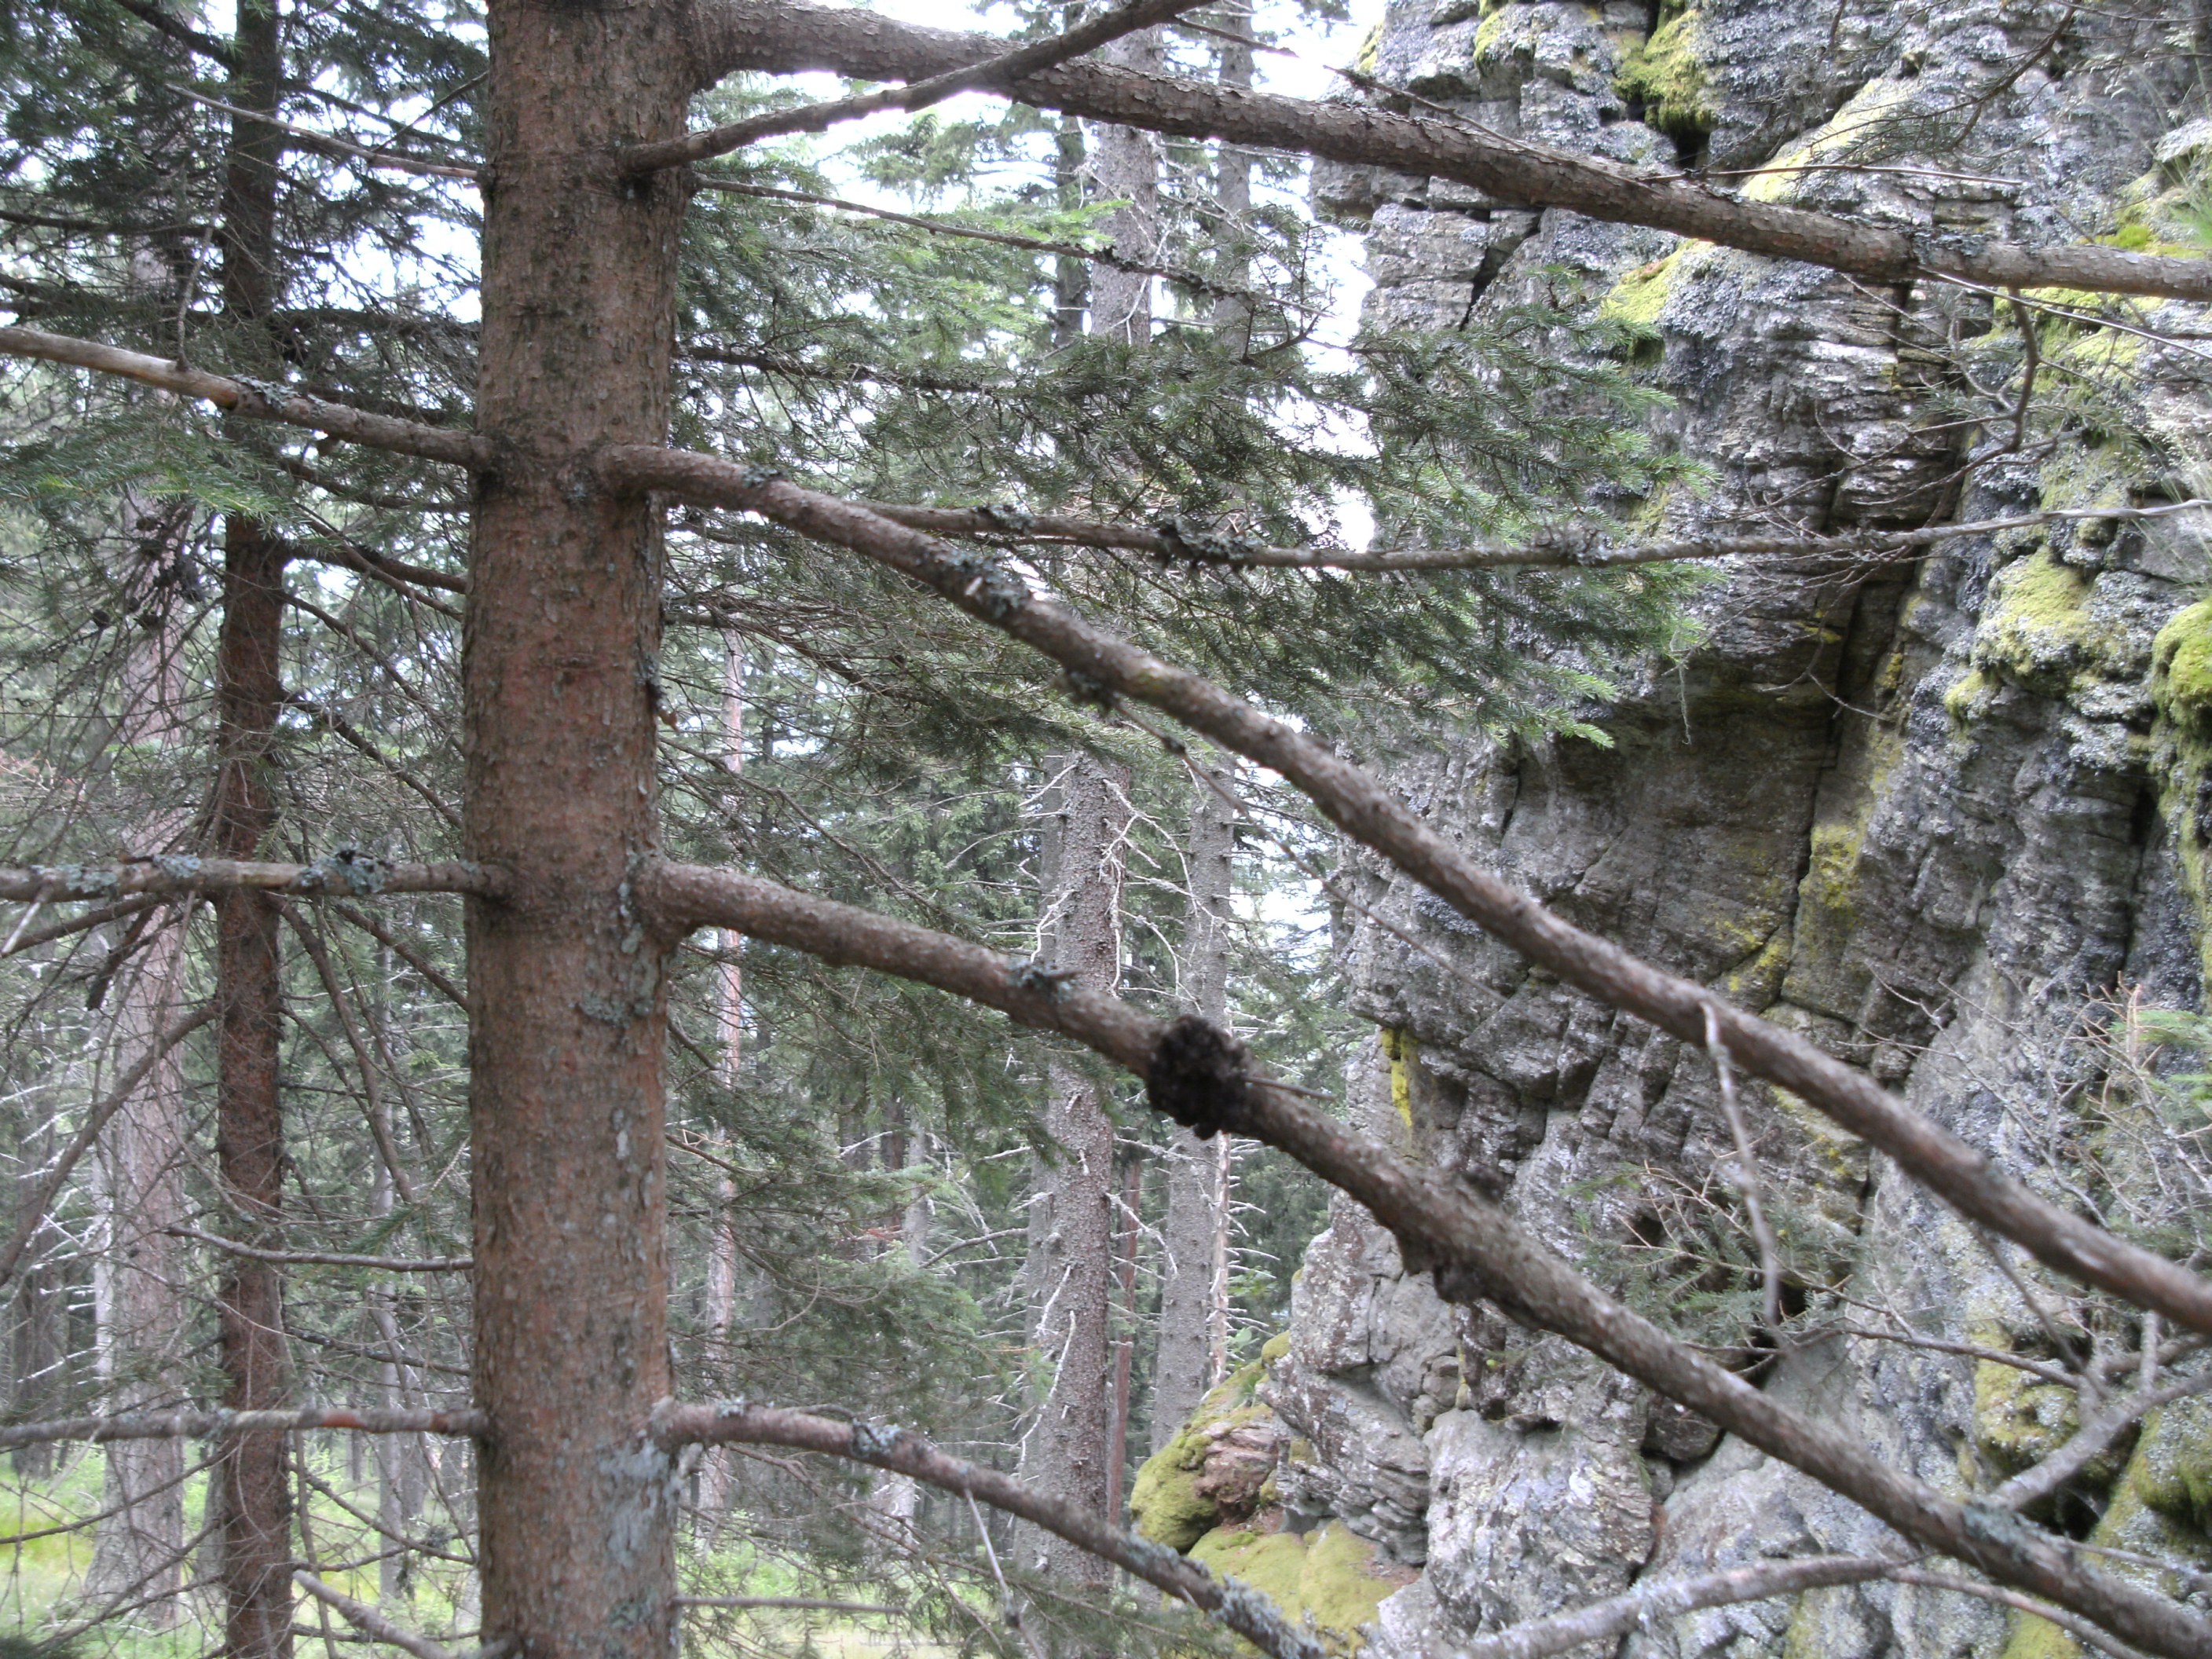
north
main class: Woodland
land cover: Spruce dominated coniferous woodland
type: alpine coniferous forest
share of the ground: 50 - 75 %
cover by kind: coniferous forest trees 70 %, shrubs 10 %, herbaceous plants 10 %, lichens and mosses 5 %, unconsolidated bare surface 5 %
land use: Forestry
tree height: > 5 m
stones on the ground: < 10 %
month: July
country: AT
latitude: 46.8430
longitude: 14.7057
